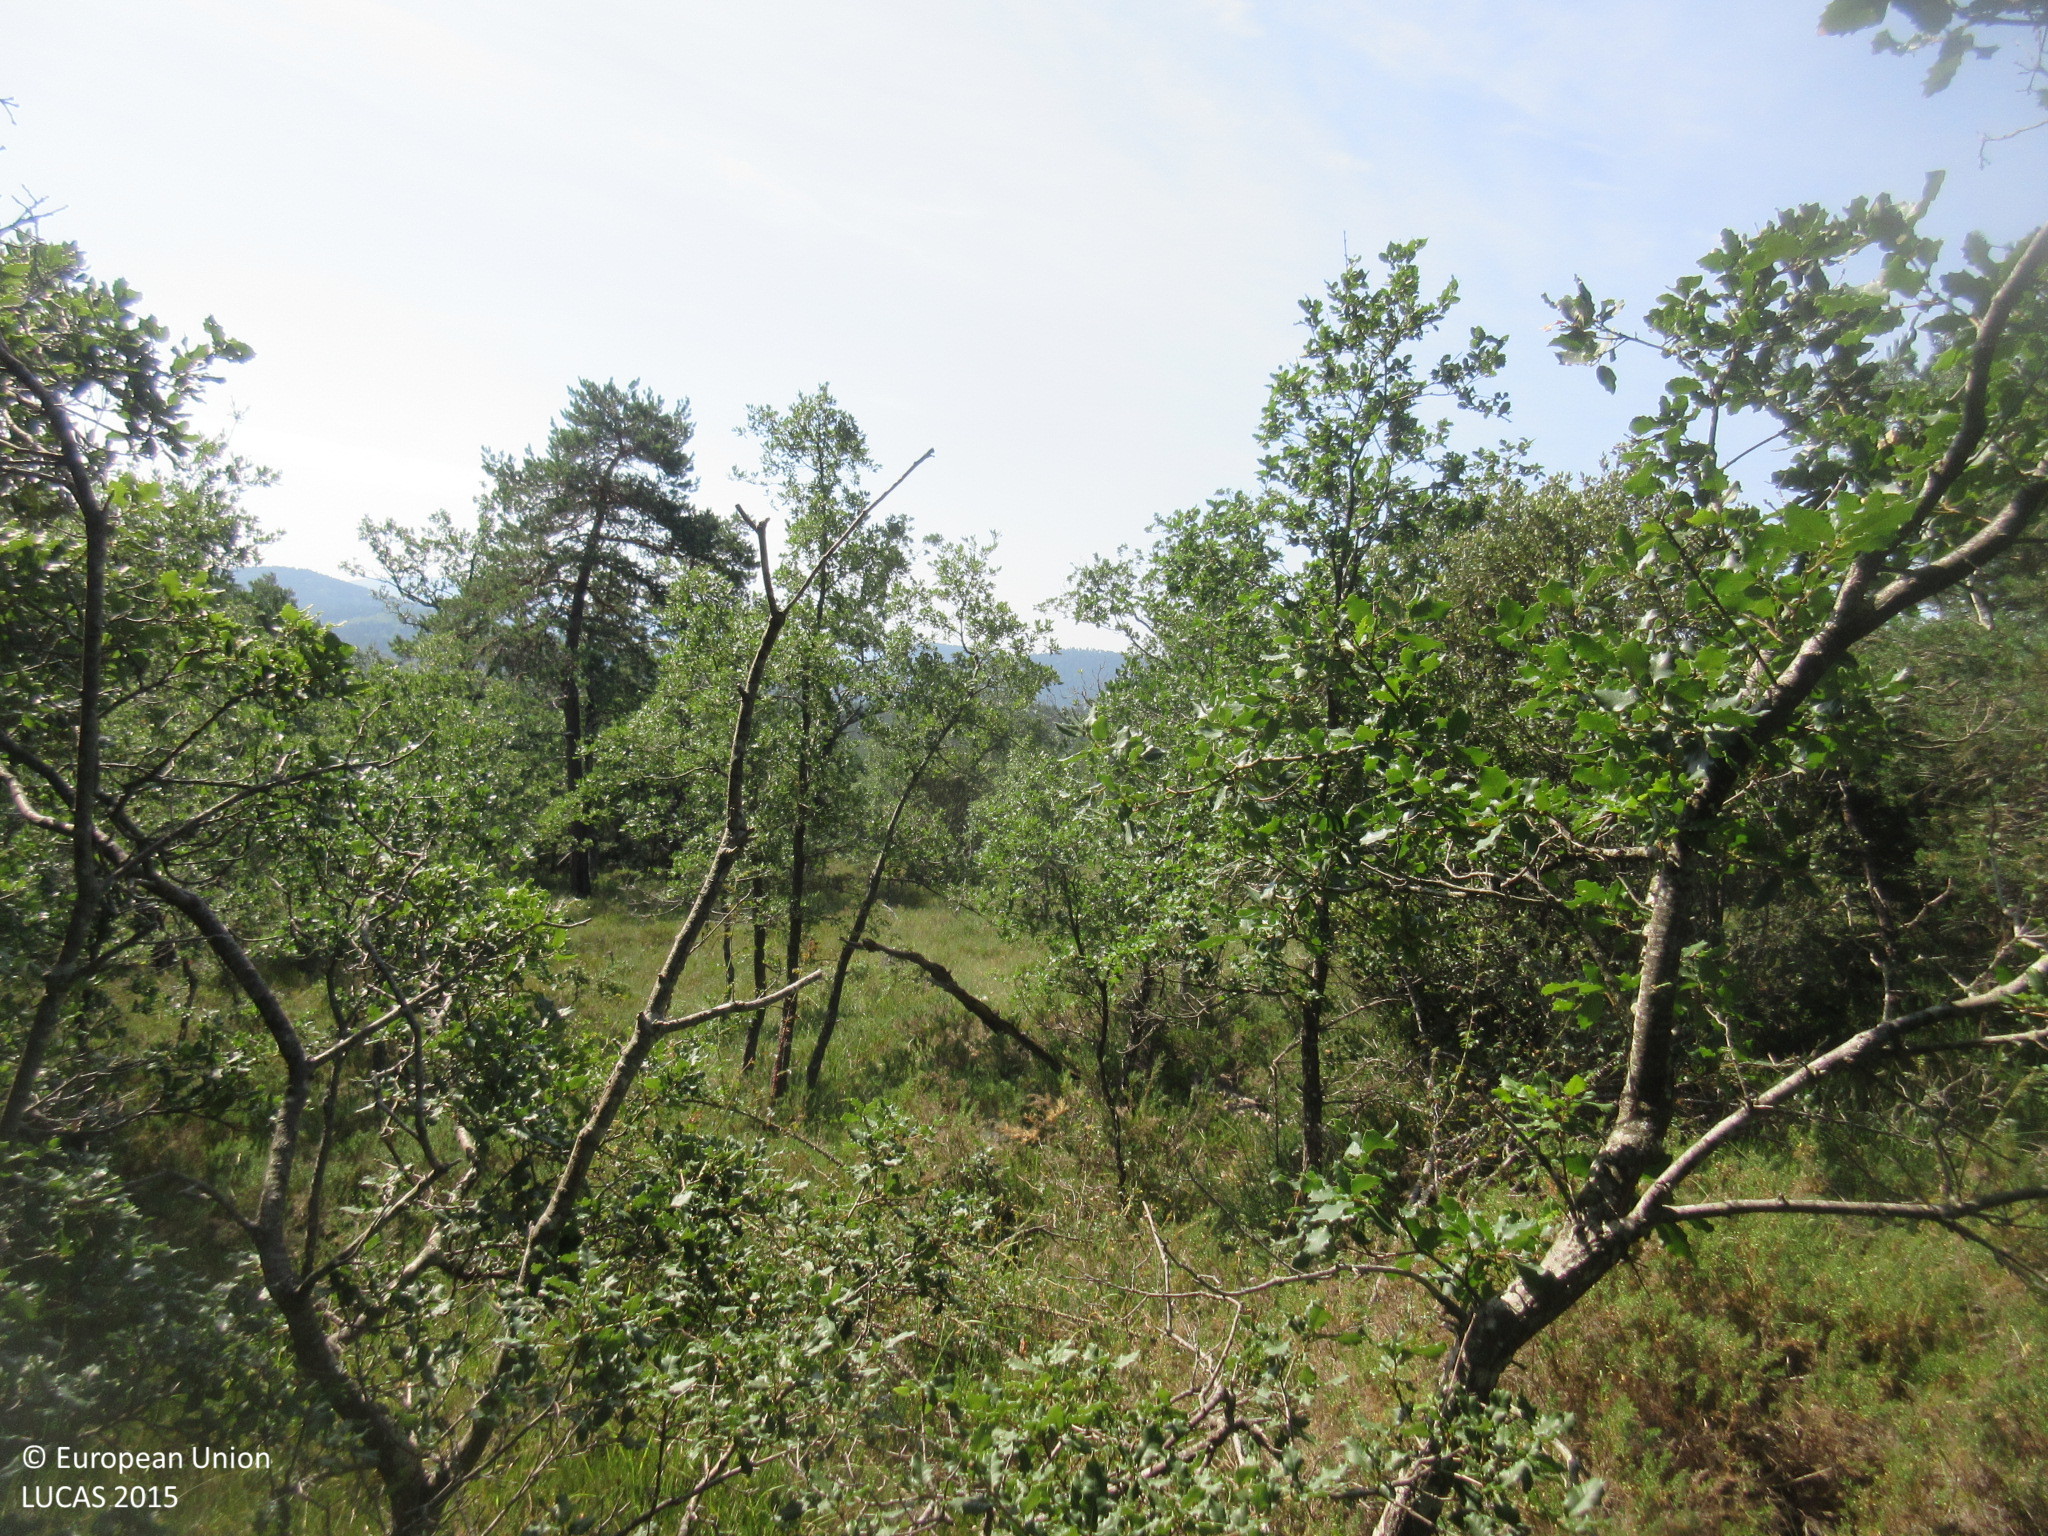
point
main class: Woodland
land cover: Broadleaved woodland
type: broadleaved evergreen forest
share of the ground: > 75 %
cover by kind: broadleaved forest trees 80 %, shrubs 20 %
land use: Forestry
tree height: > 5 m
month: July
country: ES
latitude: 42.9910
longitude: -3.3449
